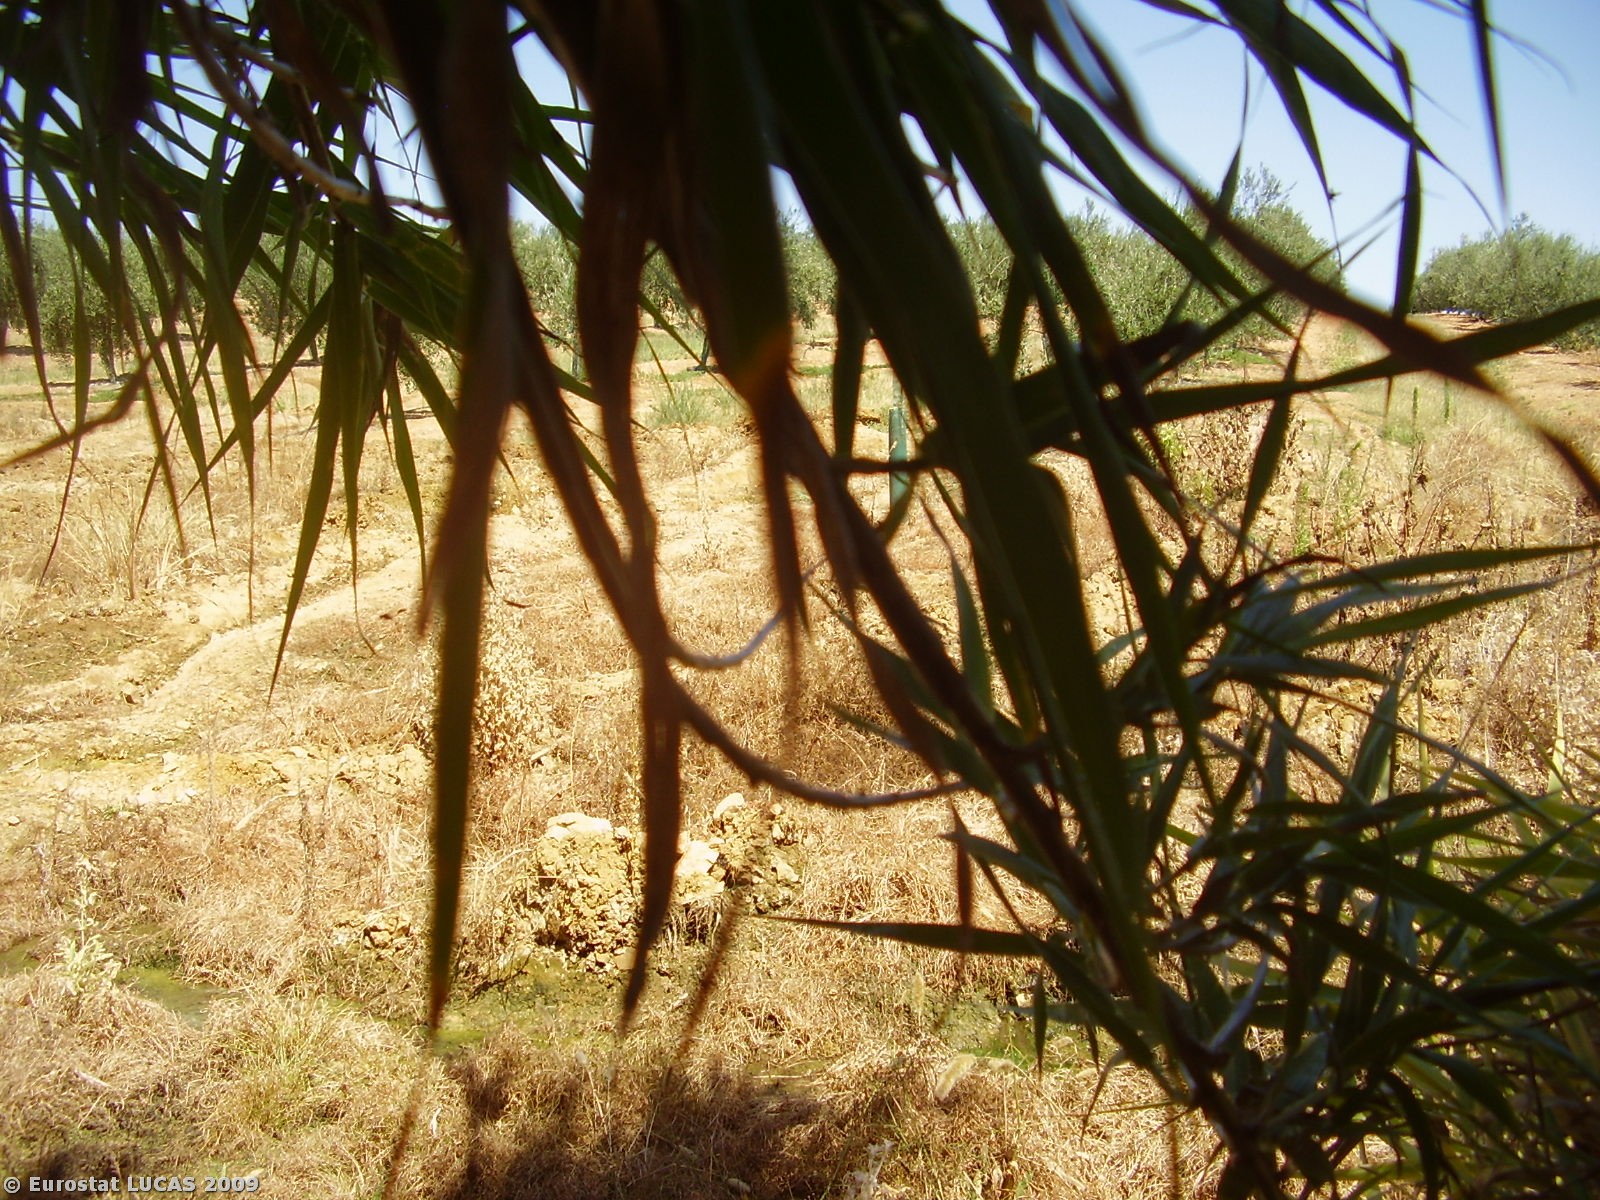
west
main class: Wetlands
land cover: Inland marshes
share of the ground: > 75 %
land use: Unused
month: July
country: PT
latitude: 38.0178
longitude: -7.7840
